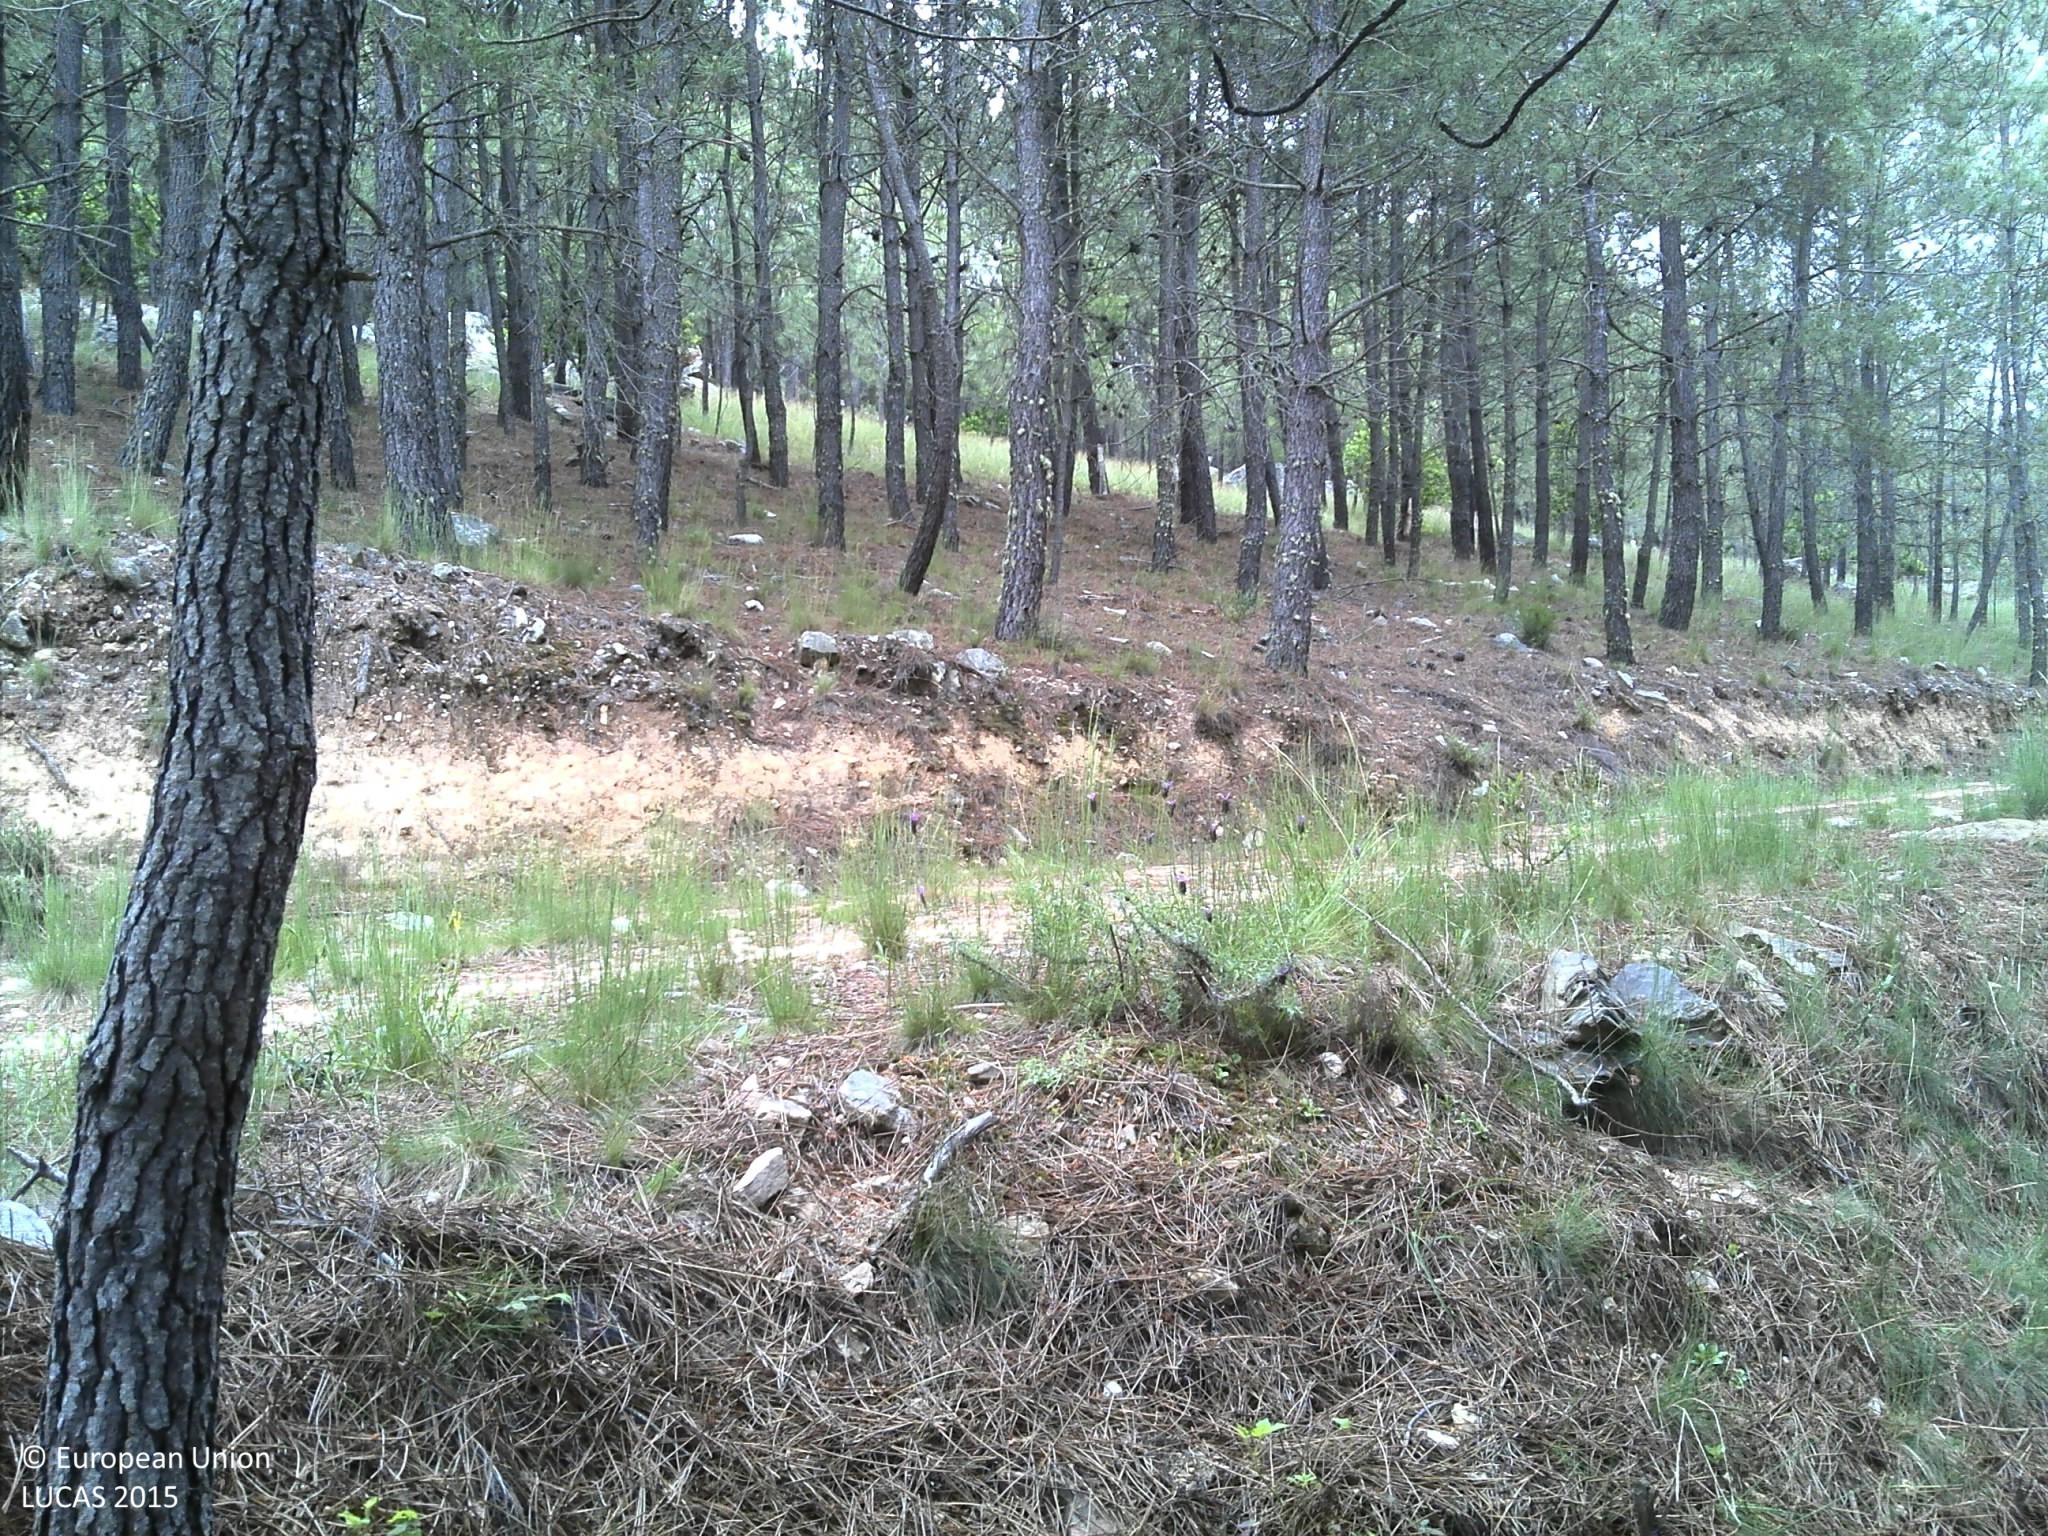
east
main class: Woodland
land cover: Pine dominated coniferous woodland
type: coniferous forest of the mediterranean region
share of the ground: 50 - 75 %
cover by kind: coniferous forest trees 75 %, unconsolidated bare surface 25 %
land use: Forestry
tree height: > 5 m
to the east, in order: Pine dominated coniferous woodland; Tracks; Pine dominated coniferous woodland; Shrubland with sparse tree cover
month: May
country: PT
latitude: 41.7461
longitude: -7.0632
